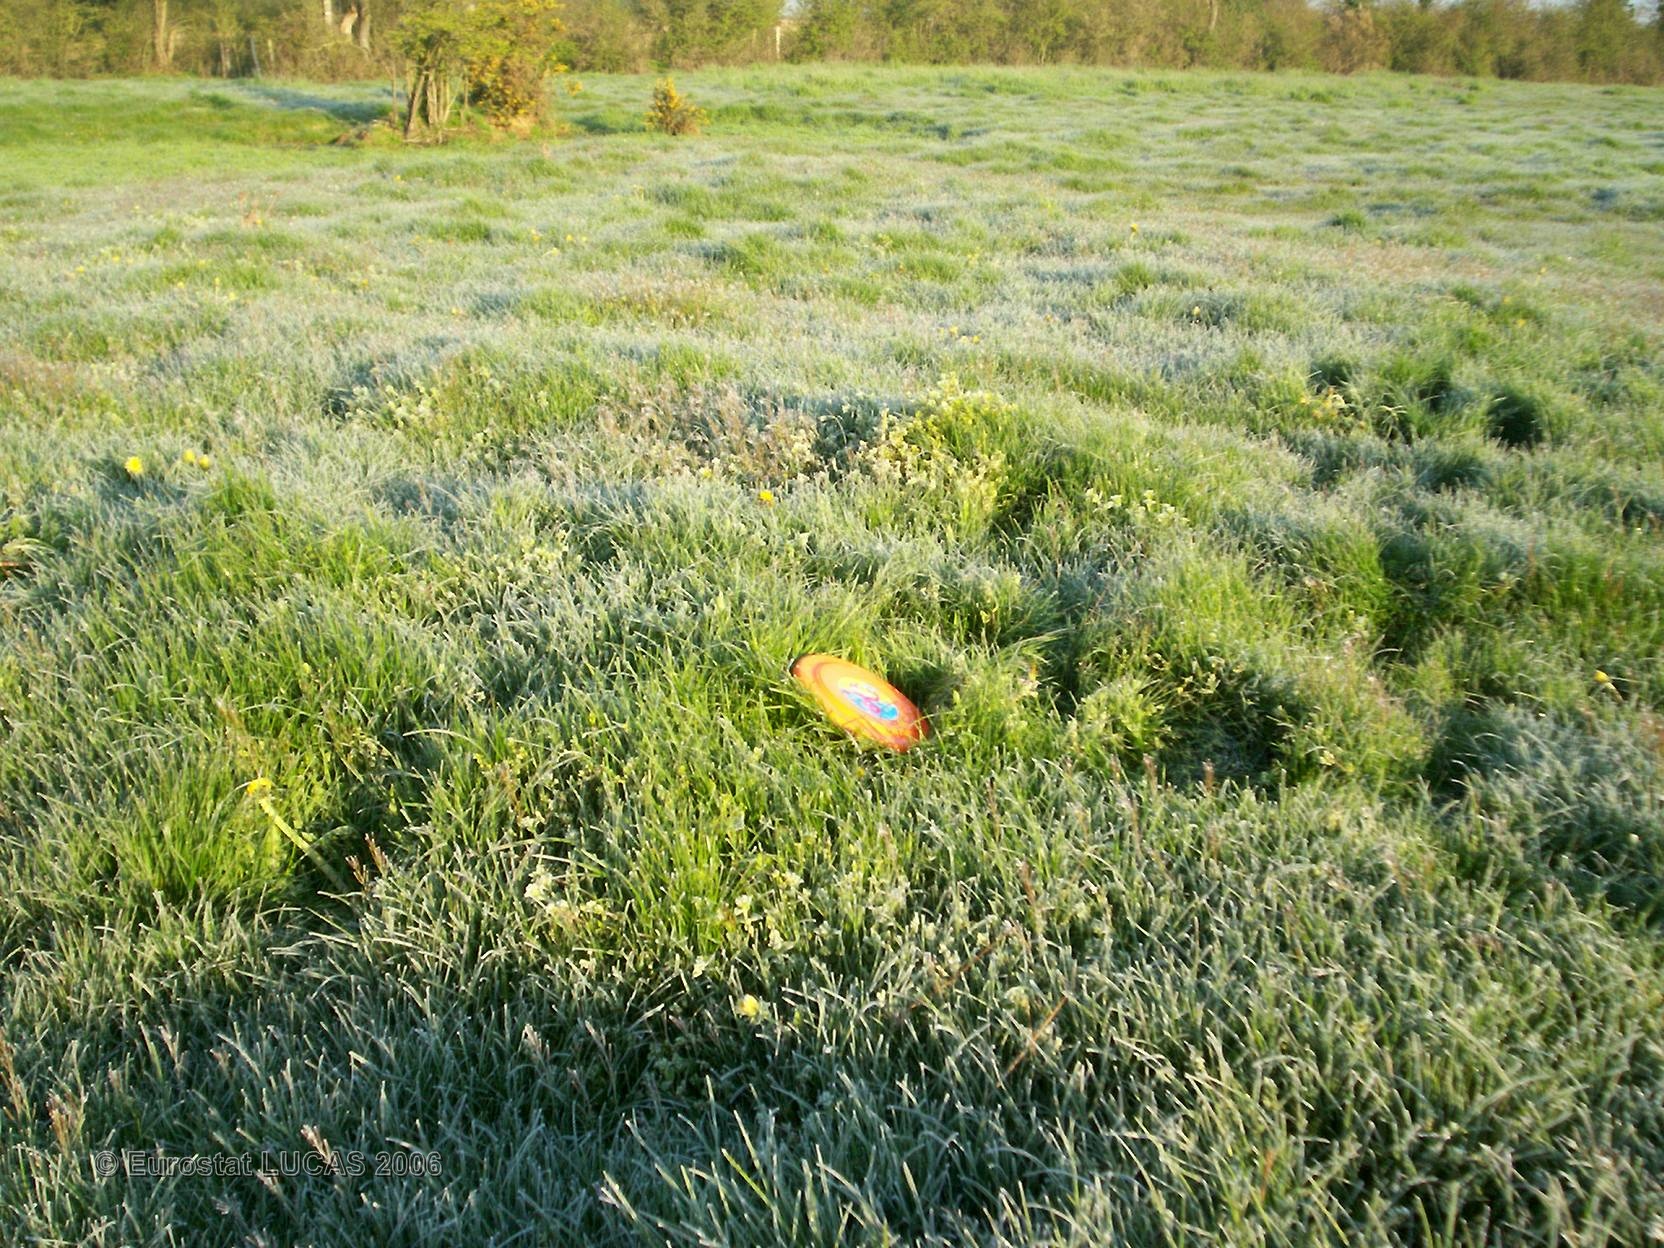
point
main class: Grassland
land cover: Grassland without tree/shrub cover
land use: Agriculture (excluding fallow land and kitchen gardens)
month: April
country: FR
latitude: 47.0418
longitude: -1.2910
